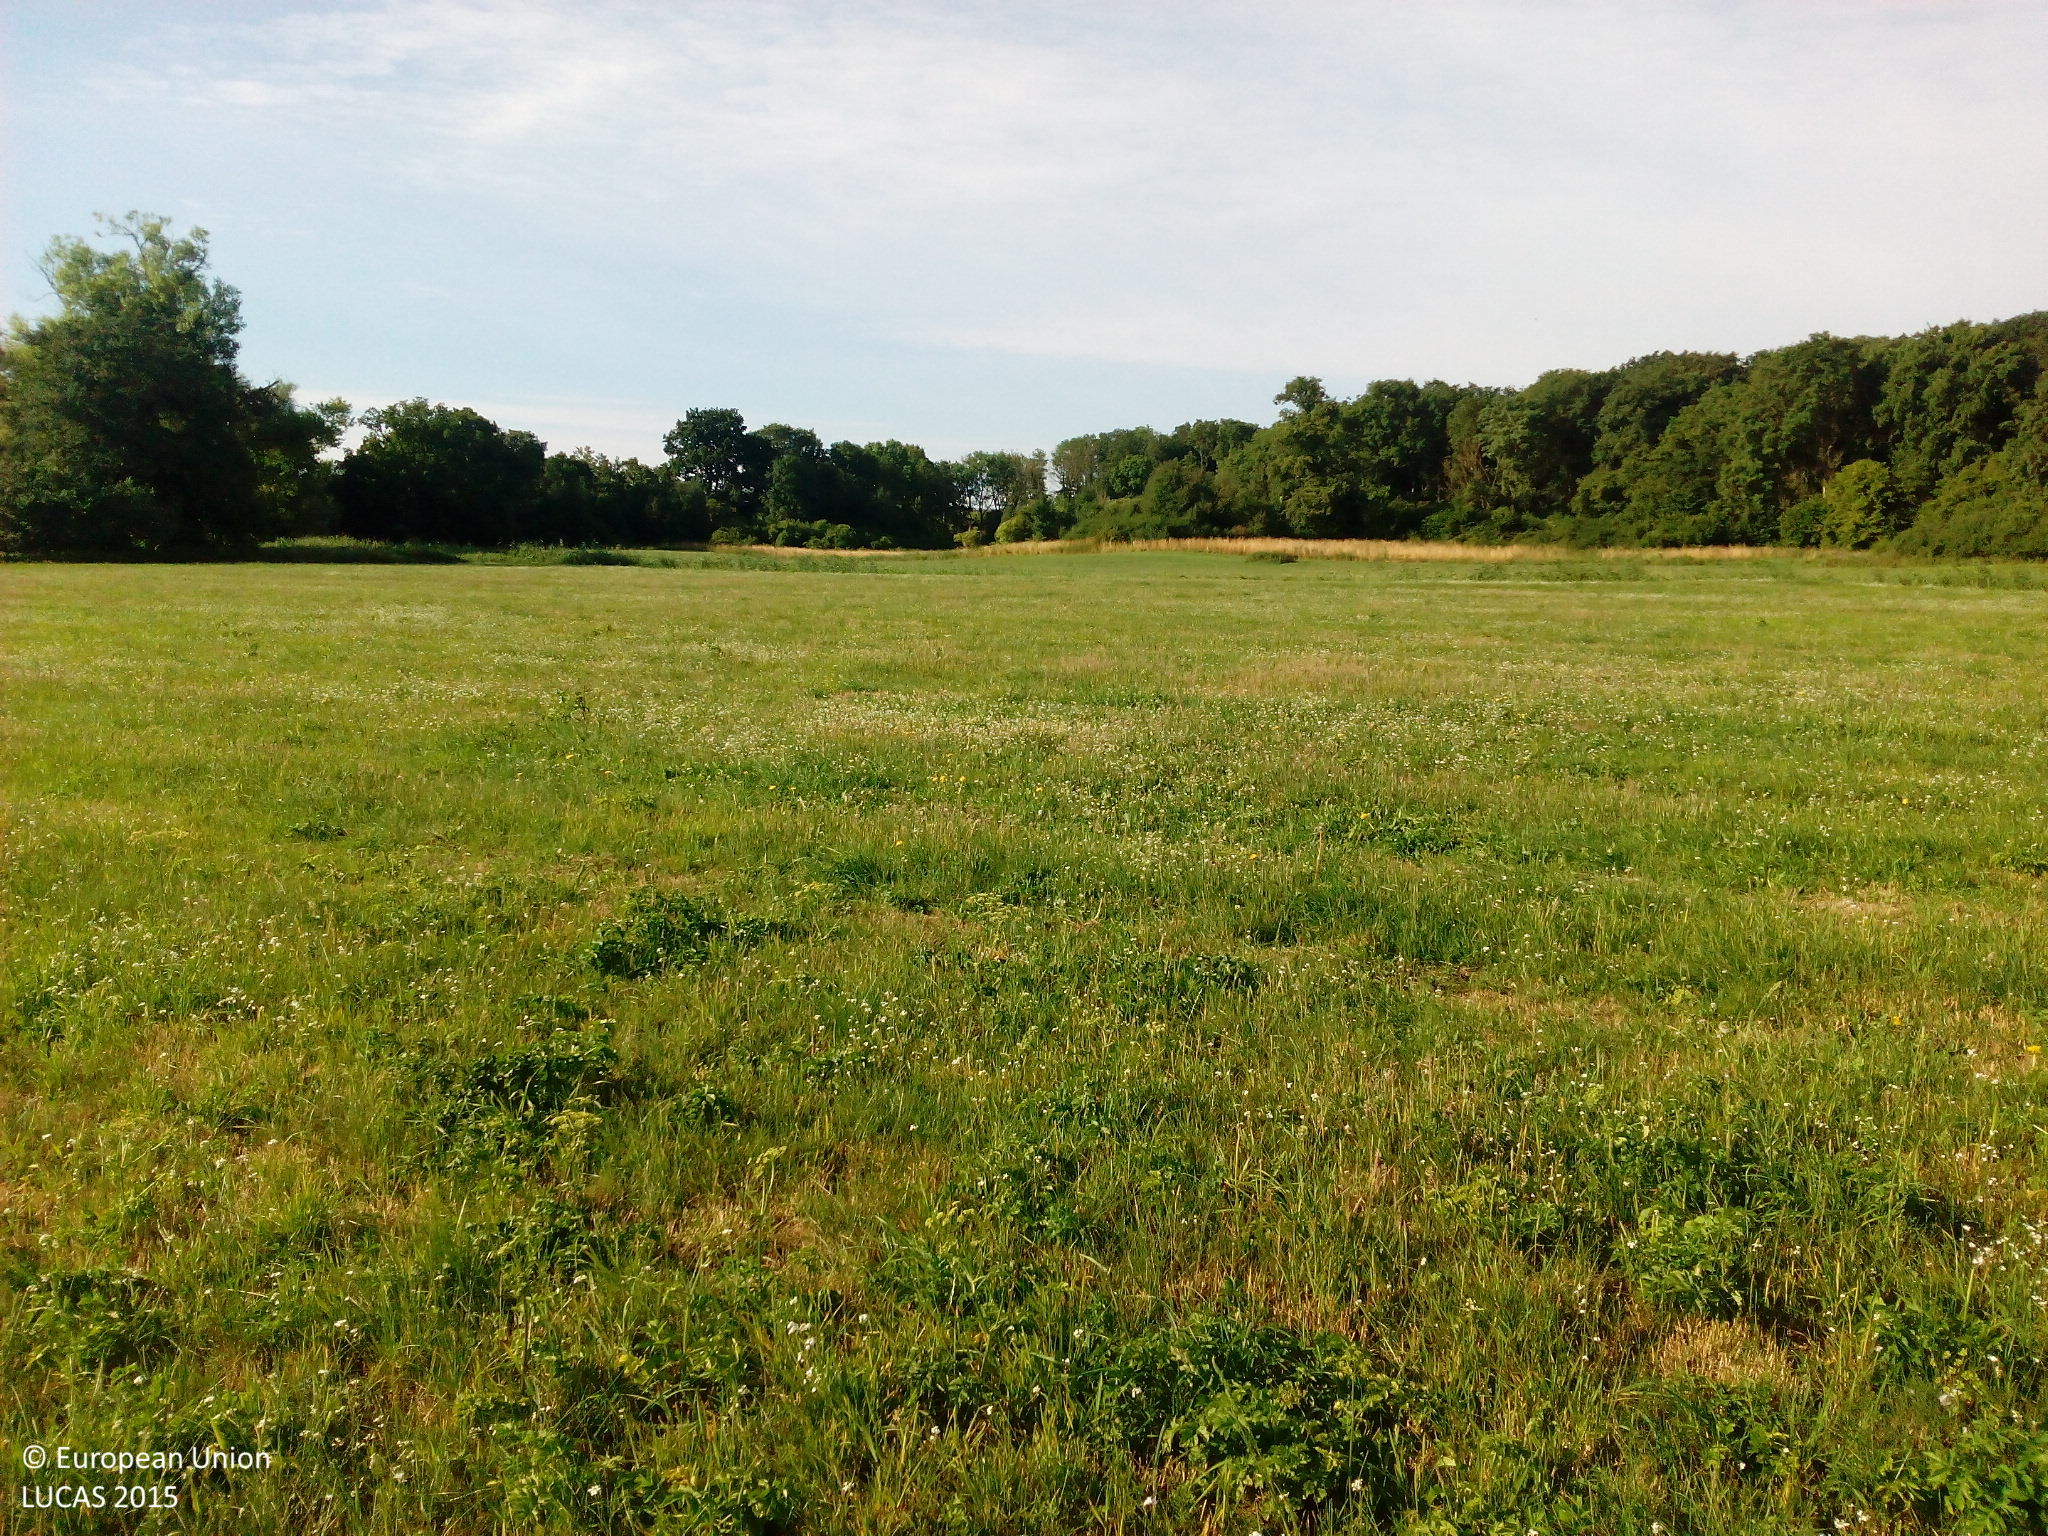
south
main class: Grassland
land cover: Grassland without tree/shrub cover
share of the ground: > 75 %
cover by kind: herbaceous plants 100 %
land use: Agriculture (excluding fallow land and kitchen gardens)
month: July
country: DE
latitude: 53.6861
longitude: 13.7400
